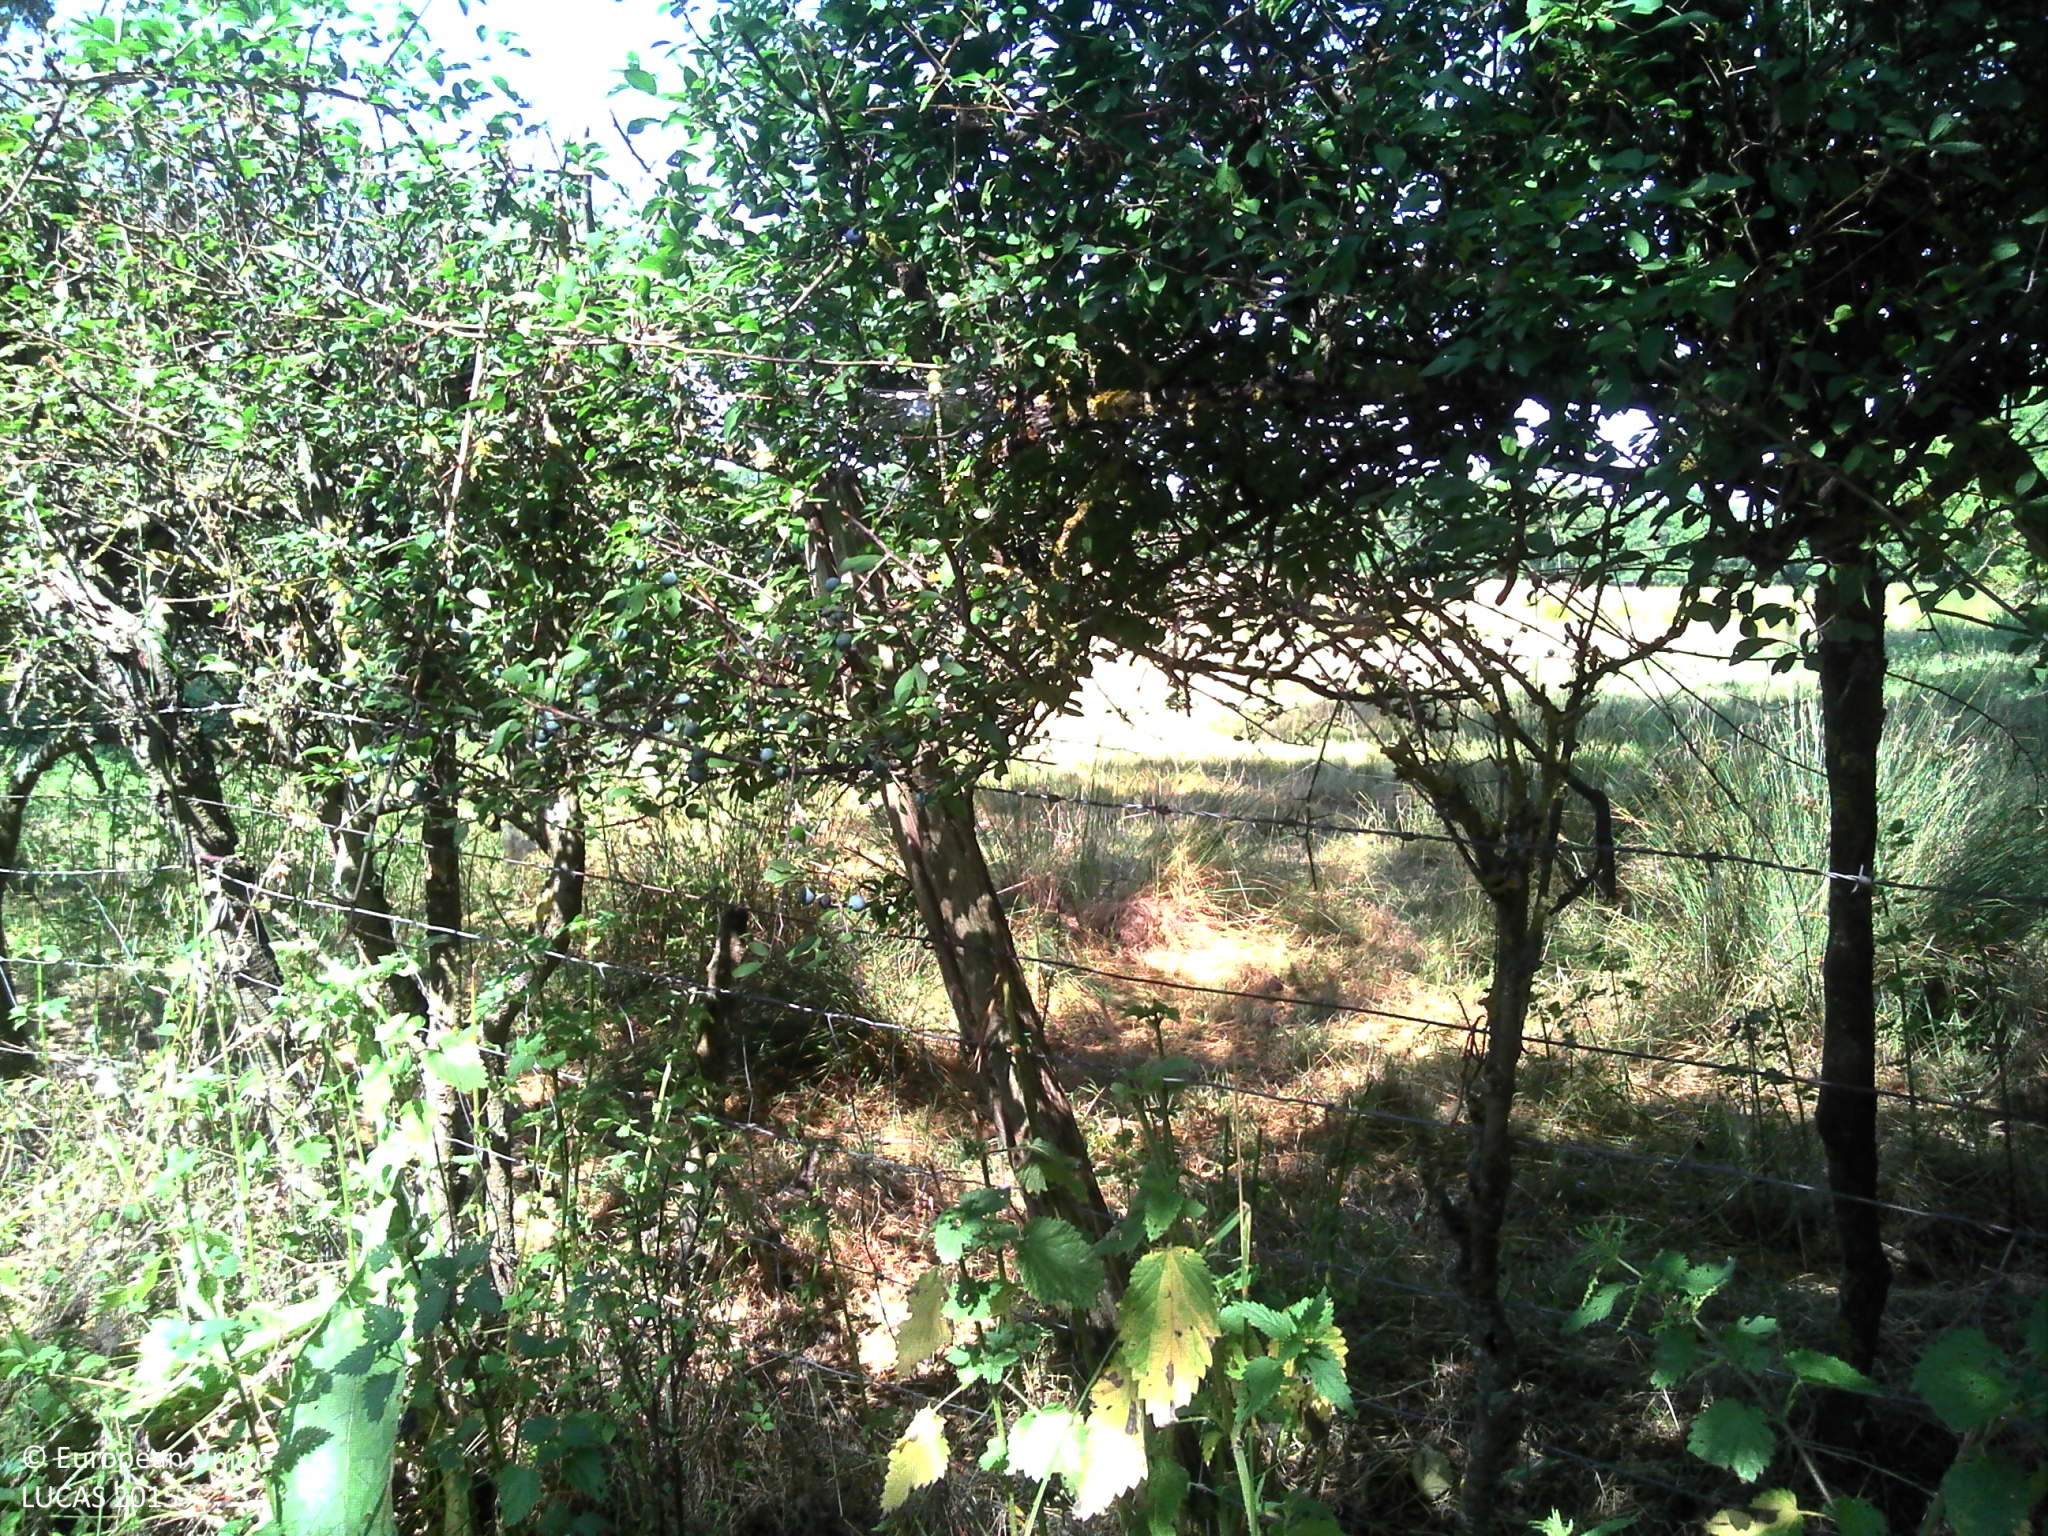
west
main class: Grassland
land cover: Grassland without tree/shrub cover
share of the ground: > 75 %
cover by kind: herbaceous plants 95 %, shrubs 5 %
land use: Agriculture (excluding fallow land and kitchen gardens)
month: July
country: FR
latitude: 46.2877
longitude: 0.8875
